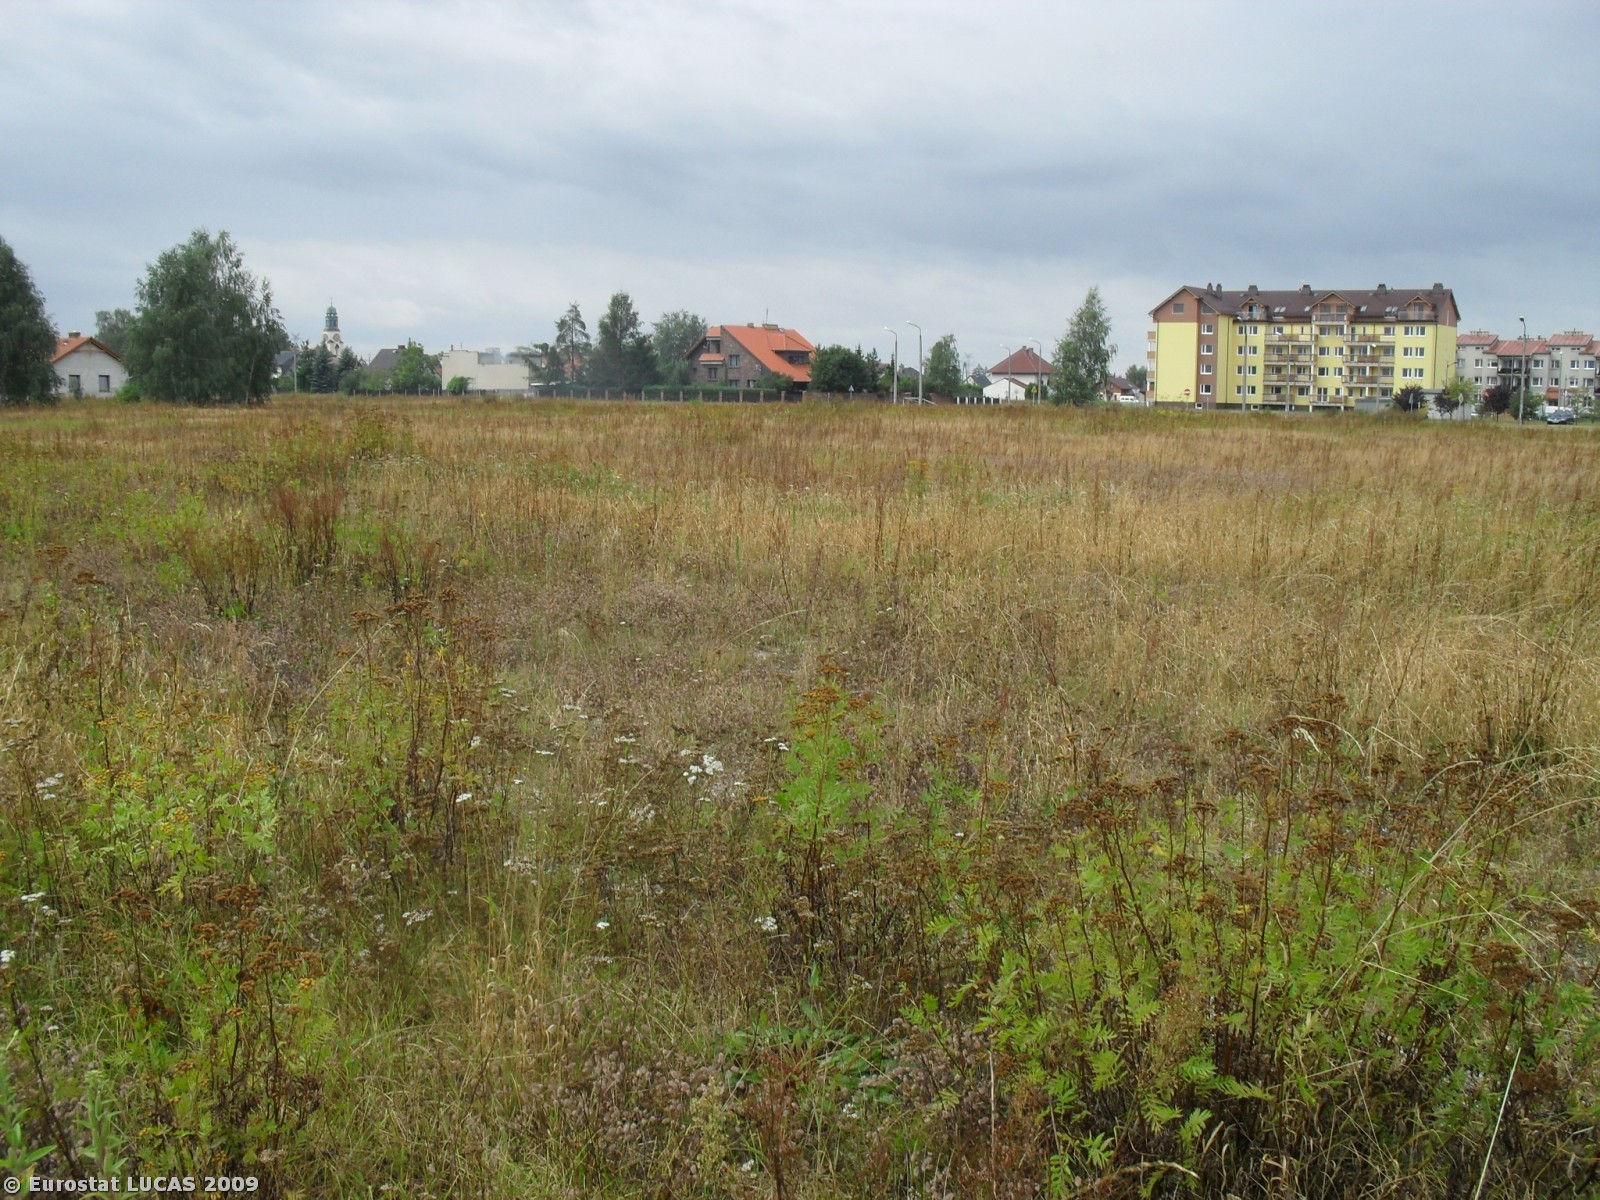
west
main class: Grassland
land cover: Grassland without tree/shrub cover
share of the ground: > 75 %
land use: Unused
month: September
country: PL
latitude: 50.7622
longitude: 17.8549
